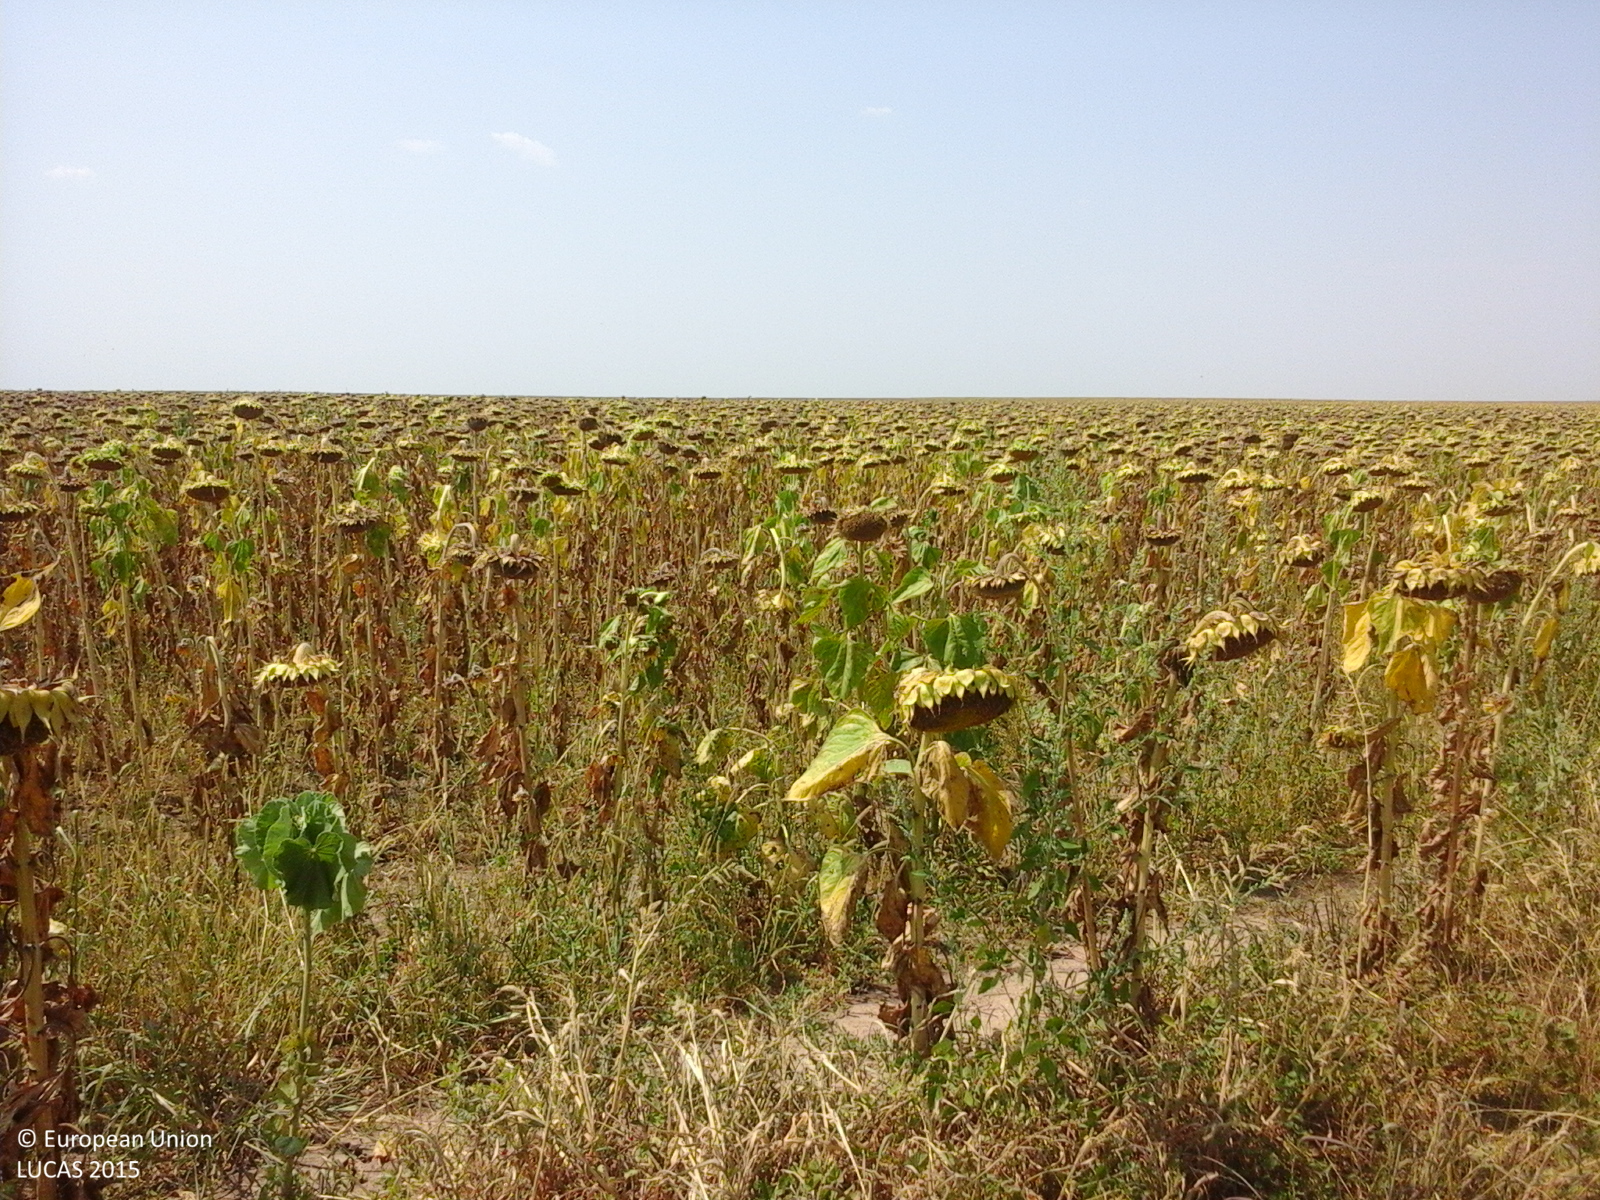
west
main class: Cropland
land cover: Sunflower
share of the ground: > 75 %
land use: Agriculture (excluding fallow land and kitchen gardens)
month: August
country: RO
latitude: 44.2522
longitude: 23.3367
